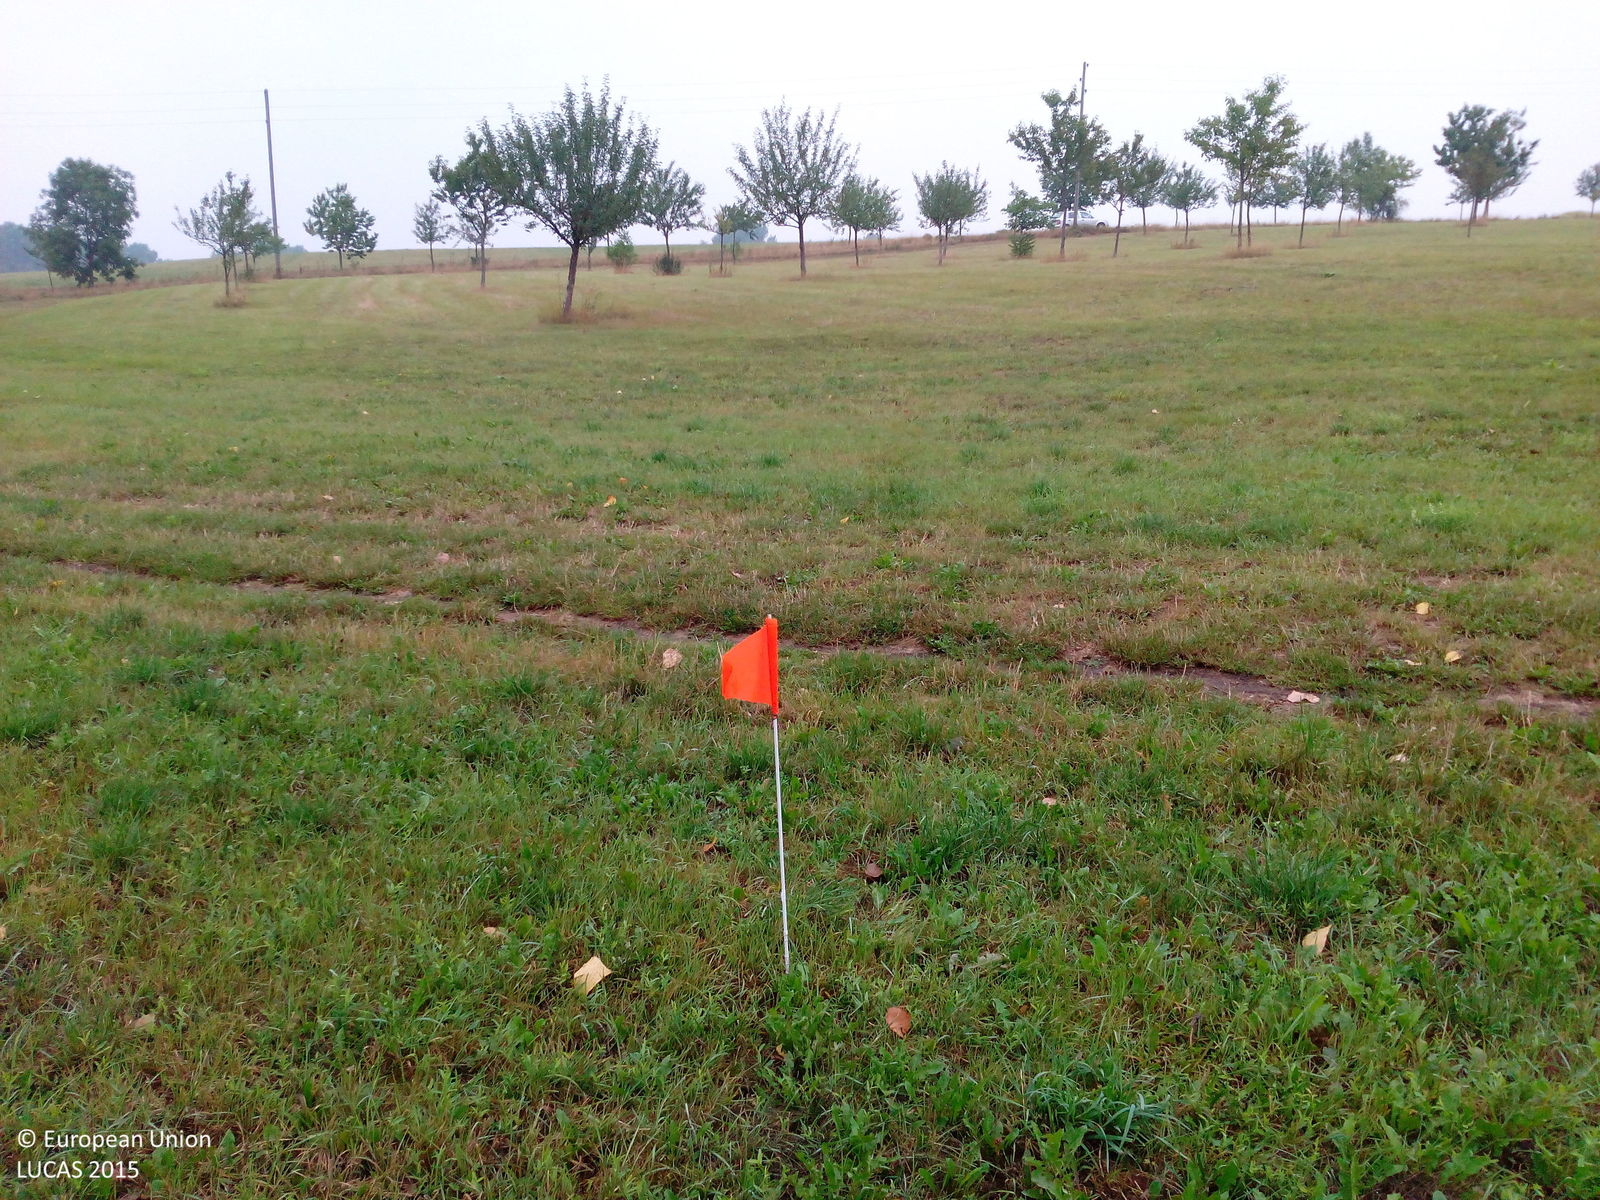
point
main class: Grassland
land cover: Grassland without tree/shrub cover
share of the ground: > 75 %
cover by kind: herbaceous plants 100 %
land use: Agriculture (excluding fallow land and kitchen gardens)
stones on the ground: 10 - 25 %
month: August
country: DE
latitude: 50.9184
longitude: 10.8390
